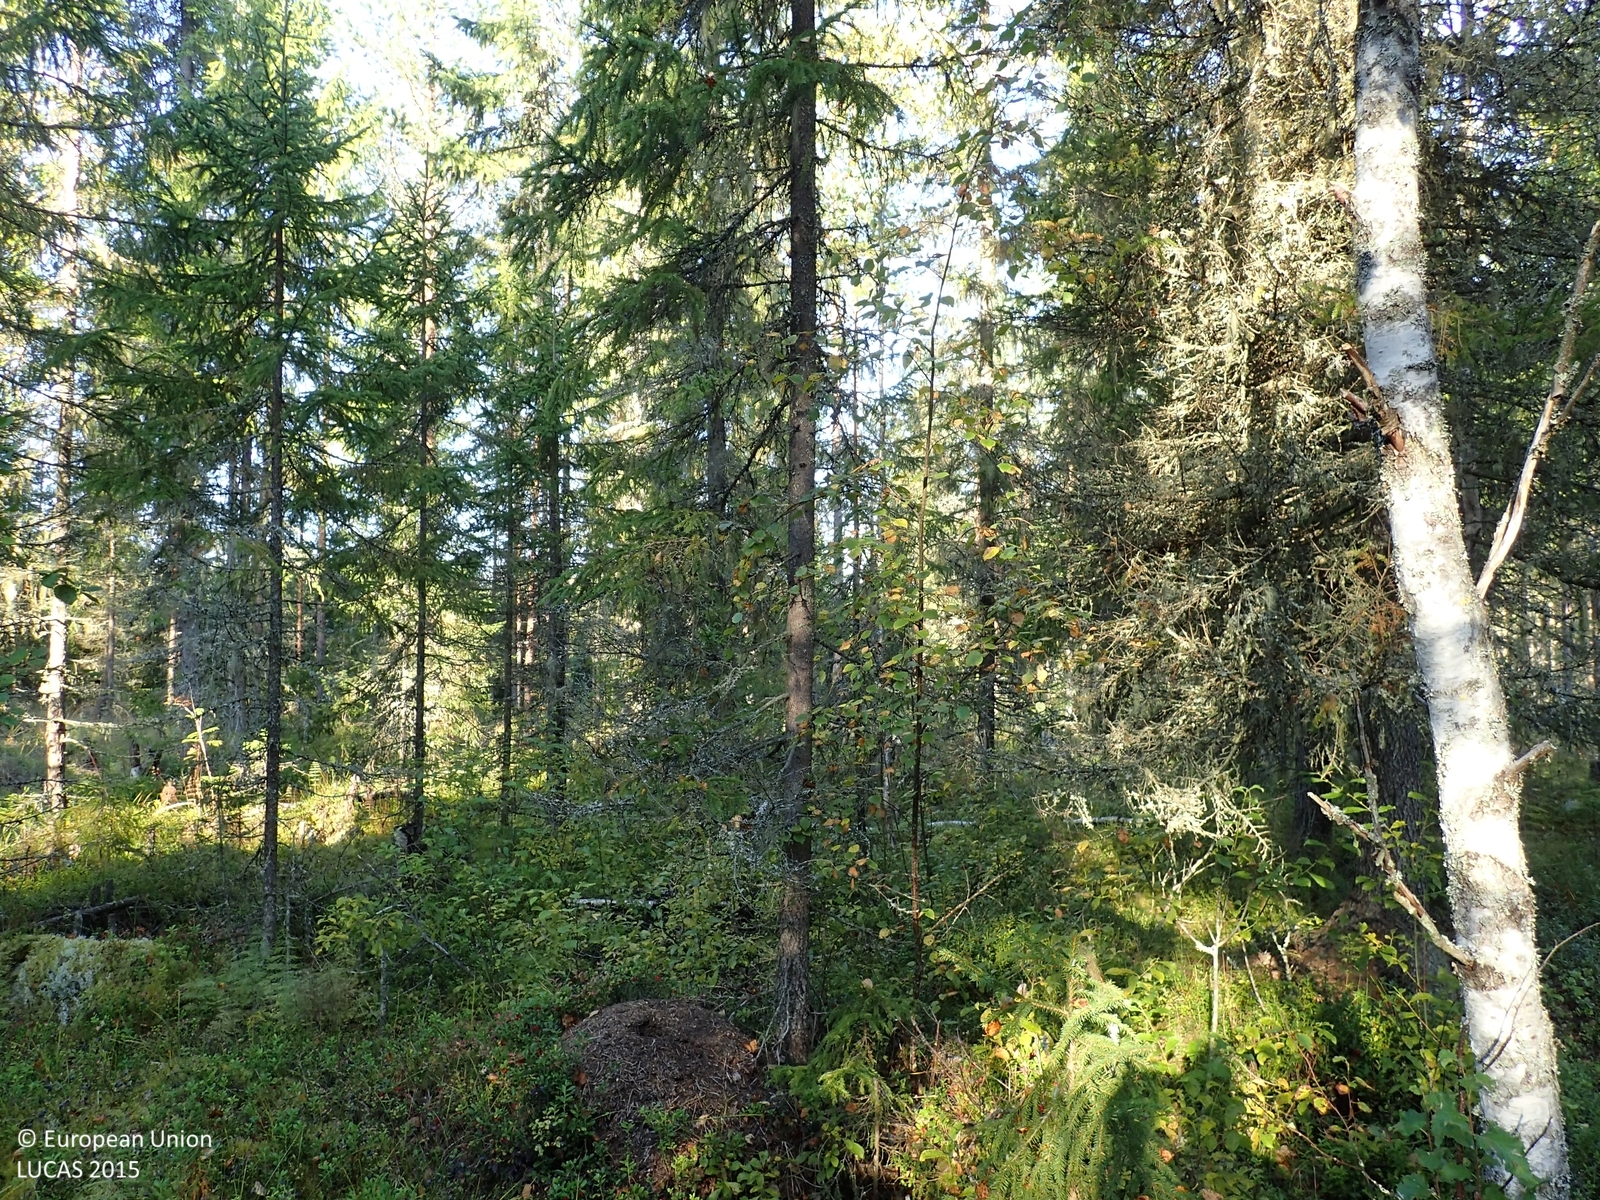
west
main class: Woodland
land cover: Spruce dominated coniferous woodland
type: boreal forest
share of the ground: > 75 %
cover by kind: coniferous forest trees 70 %, shrubs 15 %, broadleaved forest trees 5 %, herbaceous plants 5 %, lichens and mosses 5 %
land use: Forestry
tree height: > 5 m
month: September
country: FI
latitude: 63.0887
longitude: 25.3715
